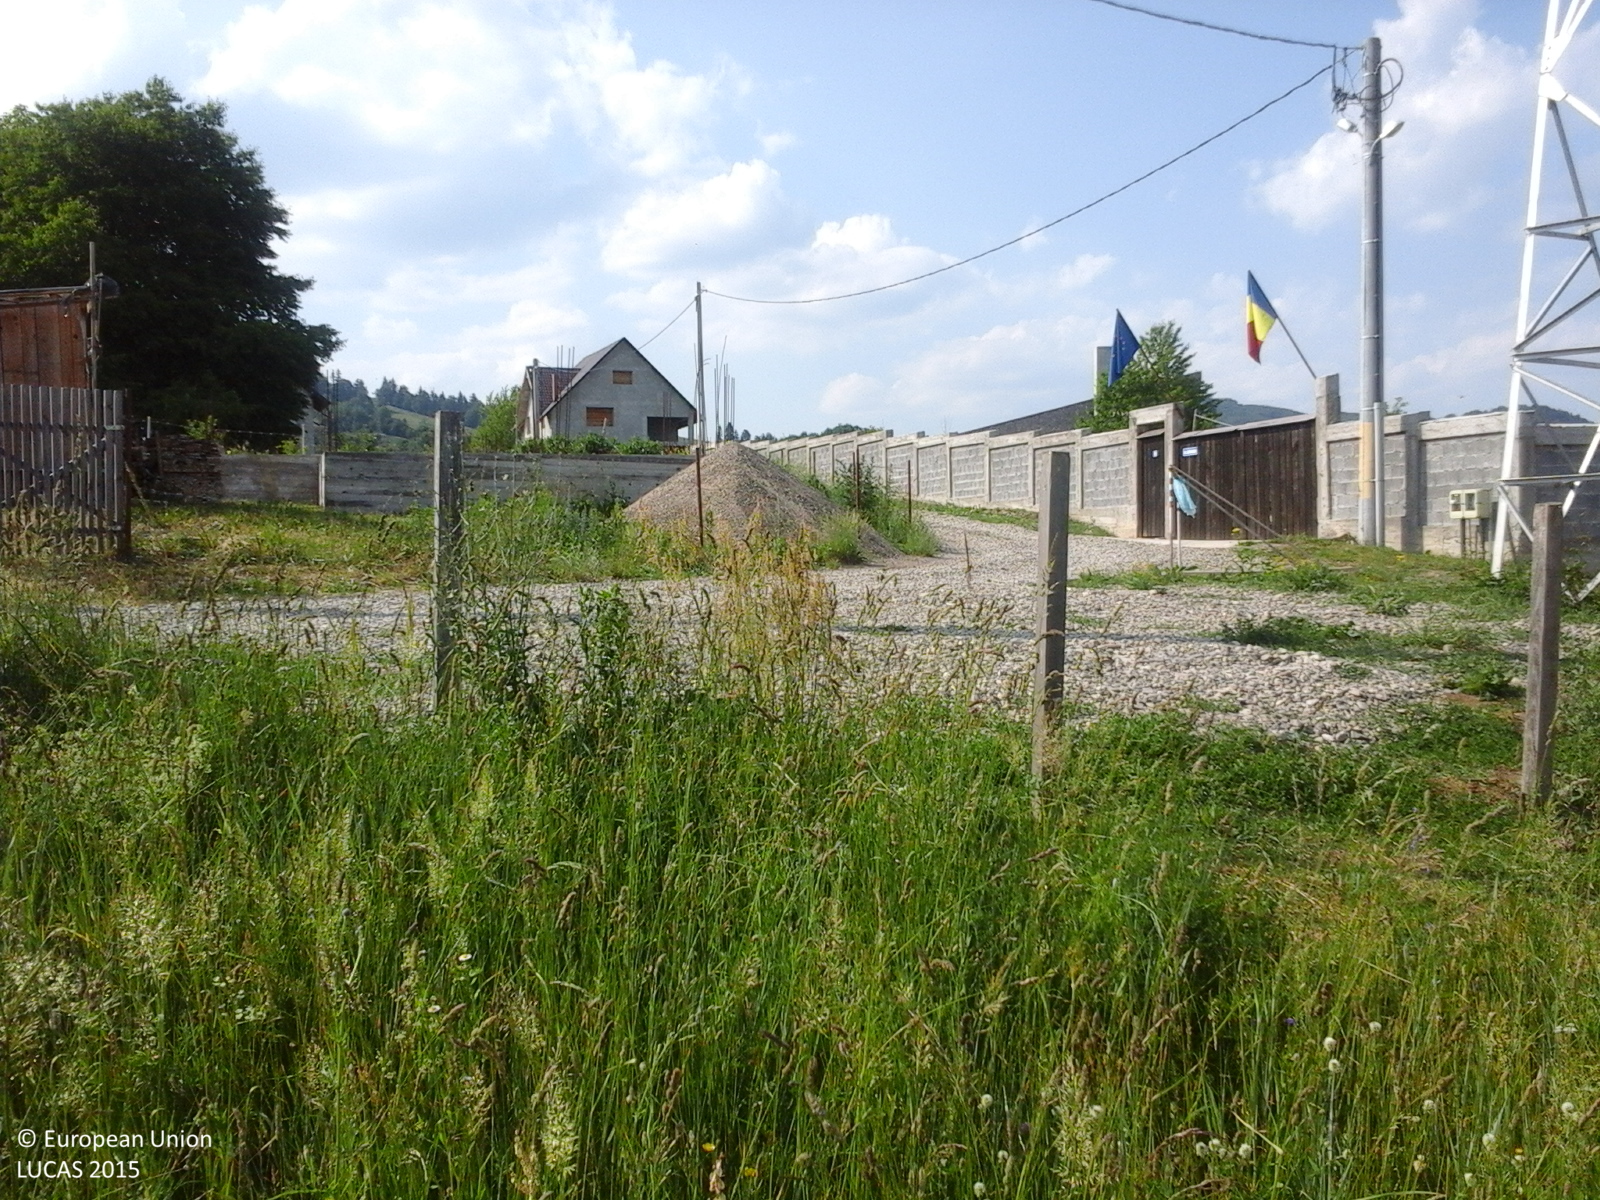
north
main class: Cropland
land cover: Other leguminous and mixtures for fodder
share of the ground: > 75 %
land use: Agriculture (excluding fallow land and kitchen gardens)
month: June
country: RO
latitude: 46.9477
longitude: 26.2788
